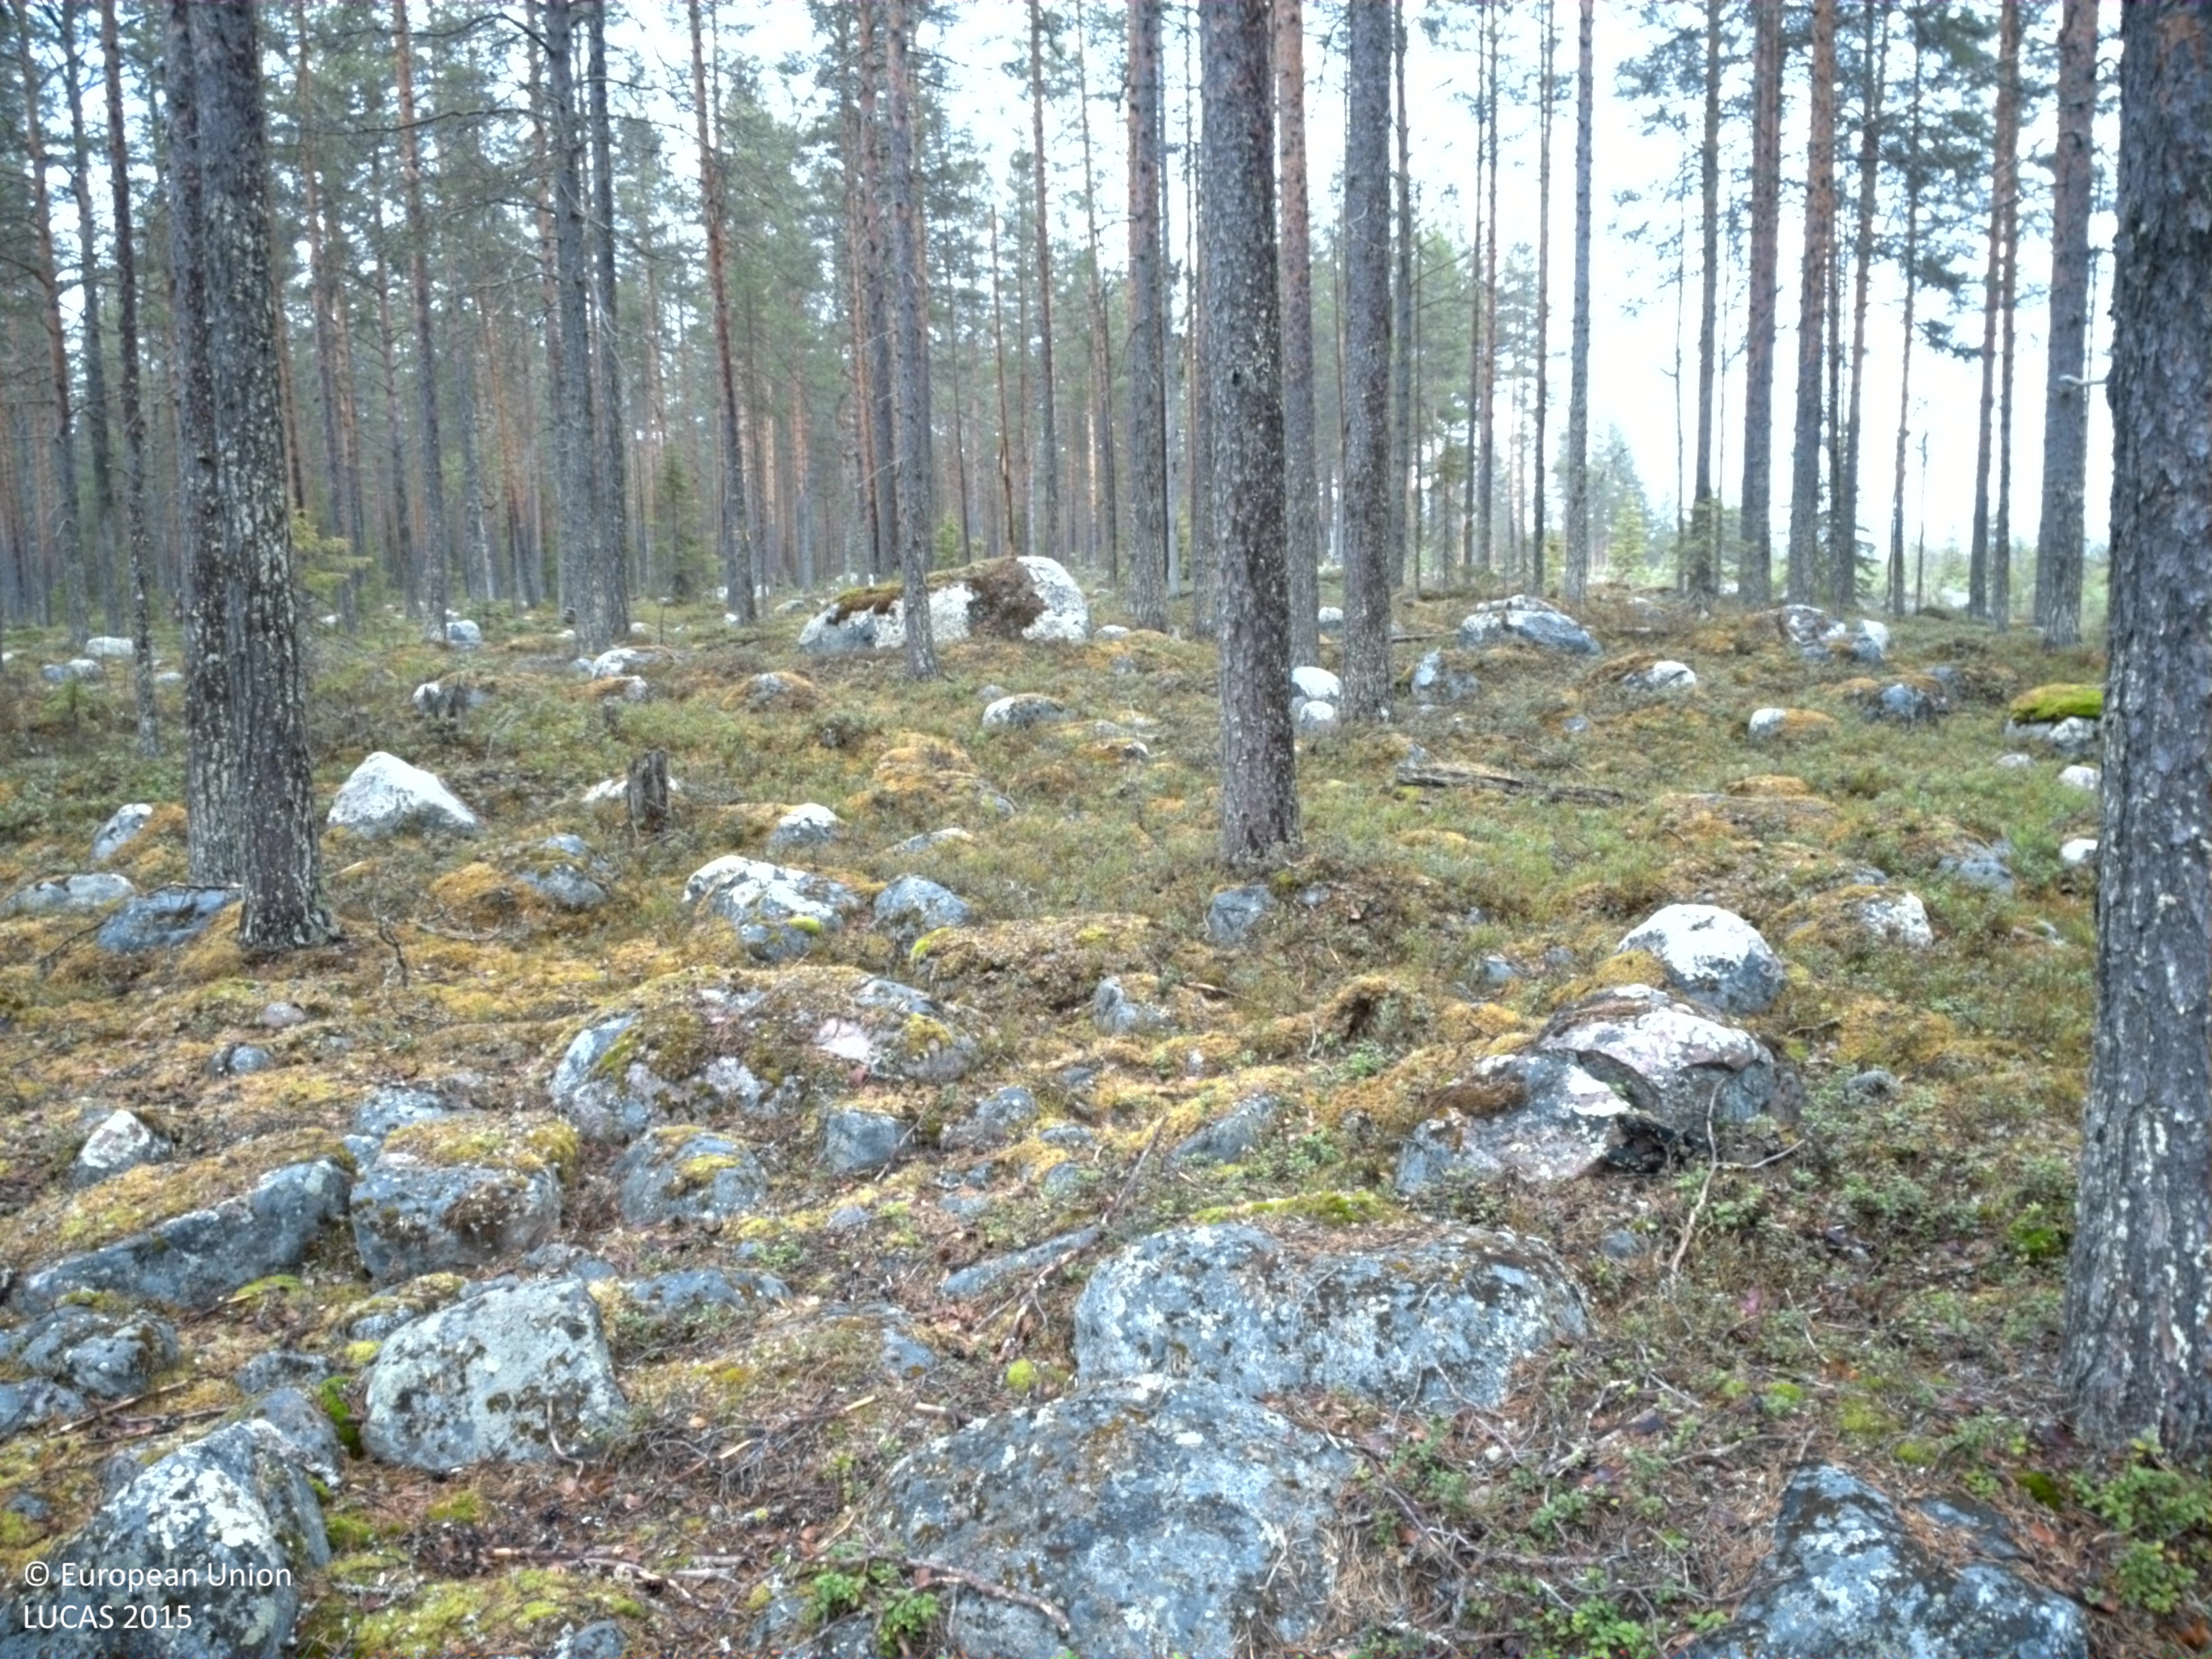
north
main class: Woodland
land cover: Pine dominated coniferous woodland
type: boreal forest
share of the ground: 50 - 75 %
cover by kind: coniferous forest trees 50 %, shrubs 25 %, consolidated bare surface 20 %, lichens and mosses 5 %
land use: Forestry
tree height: > 5 m
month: May
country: SE
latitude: 66.0837
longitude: 23.0034
